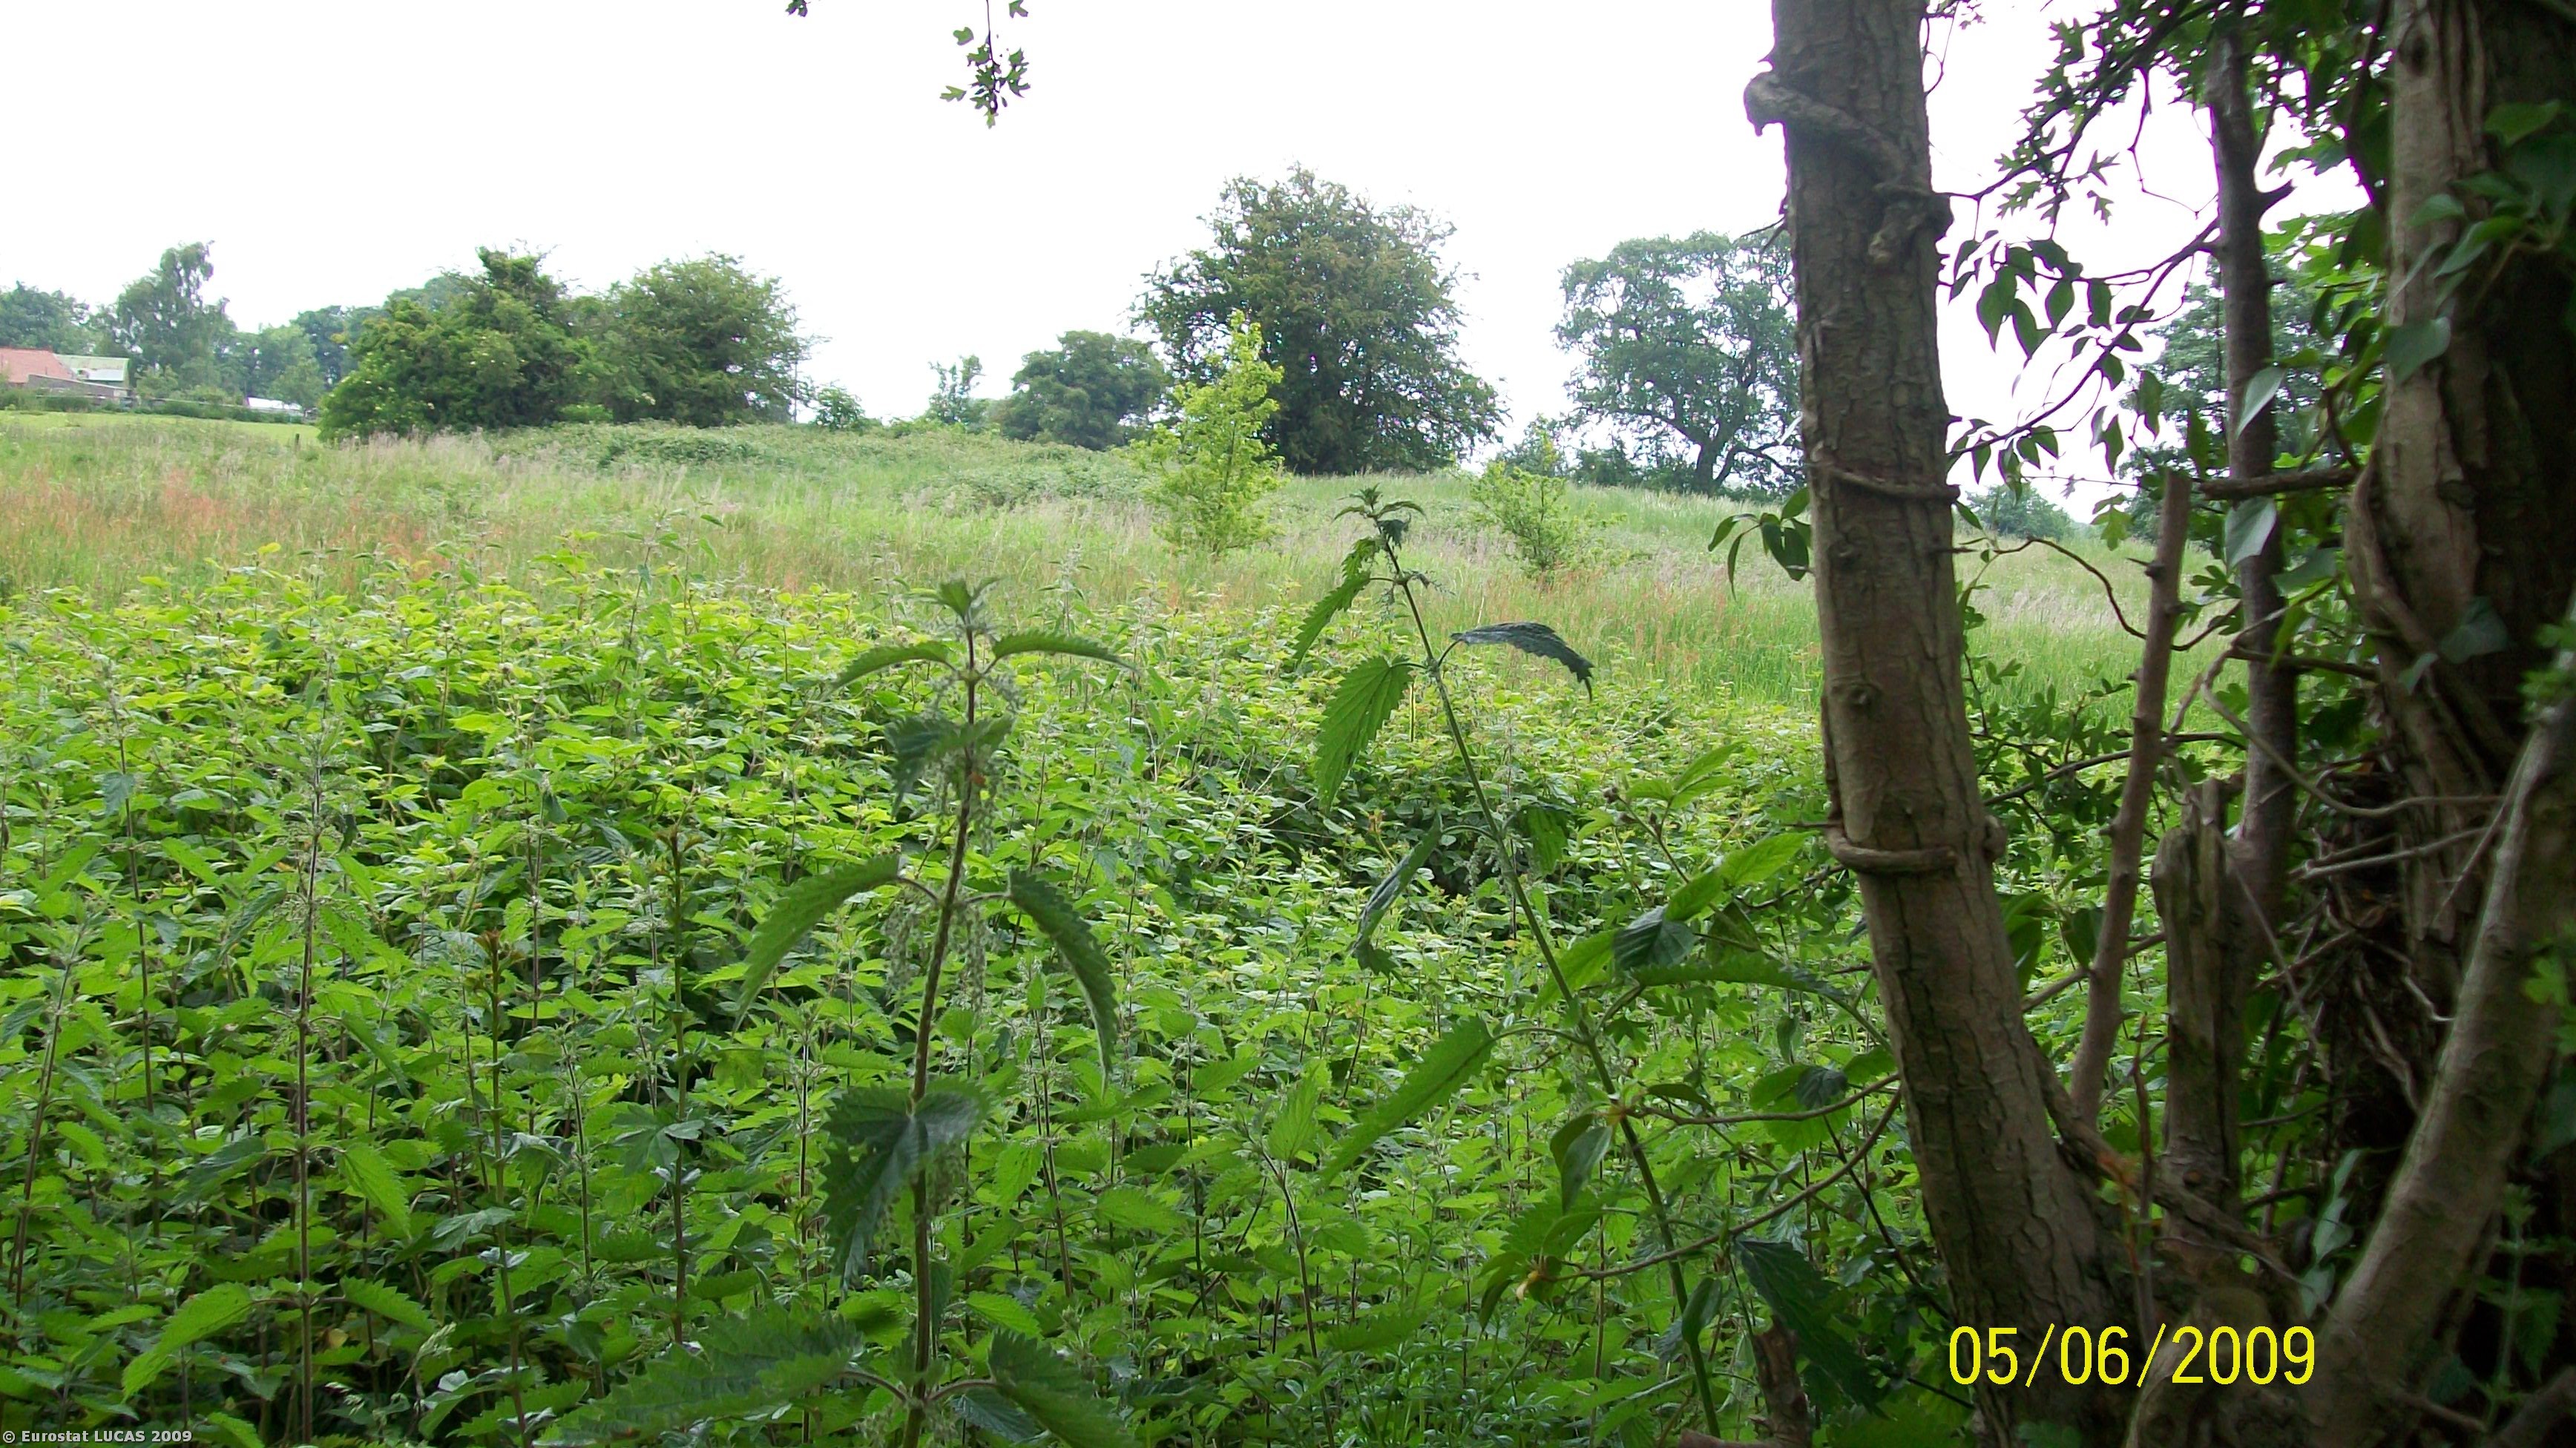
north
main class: Grassland
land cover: Grassland without tree/shrub cover
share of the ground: > 75 %
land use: Fallow land
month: June
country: GB
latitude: 53.0984
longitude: -2.6584
